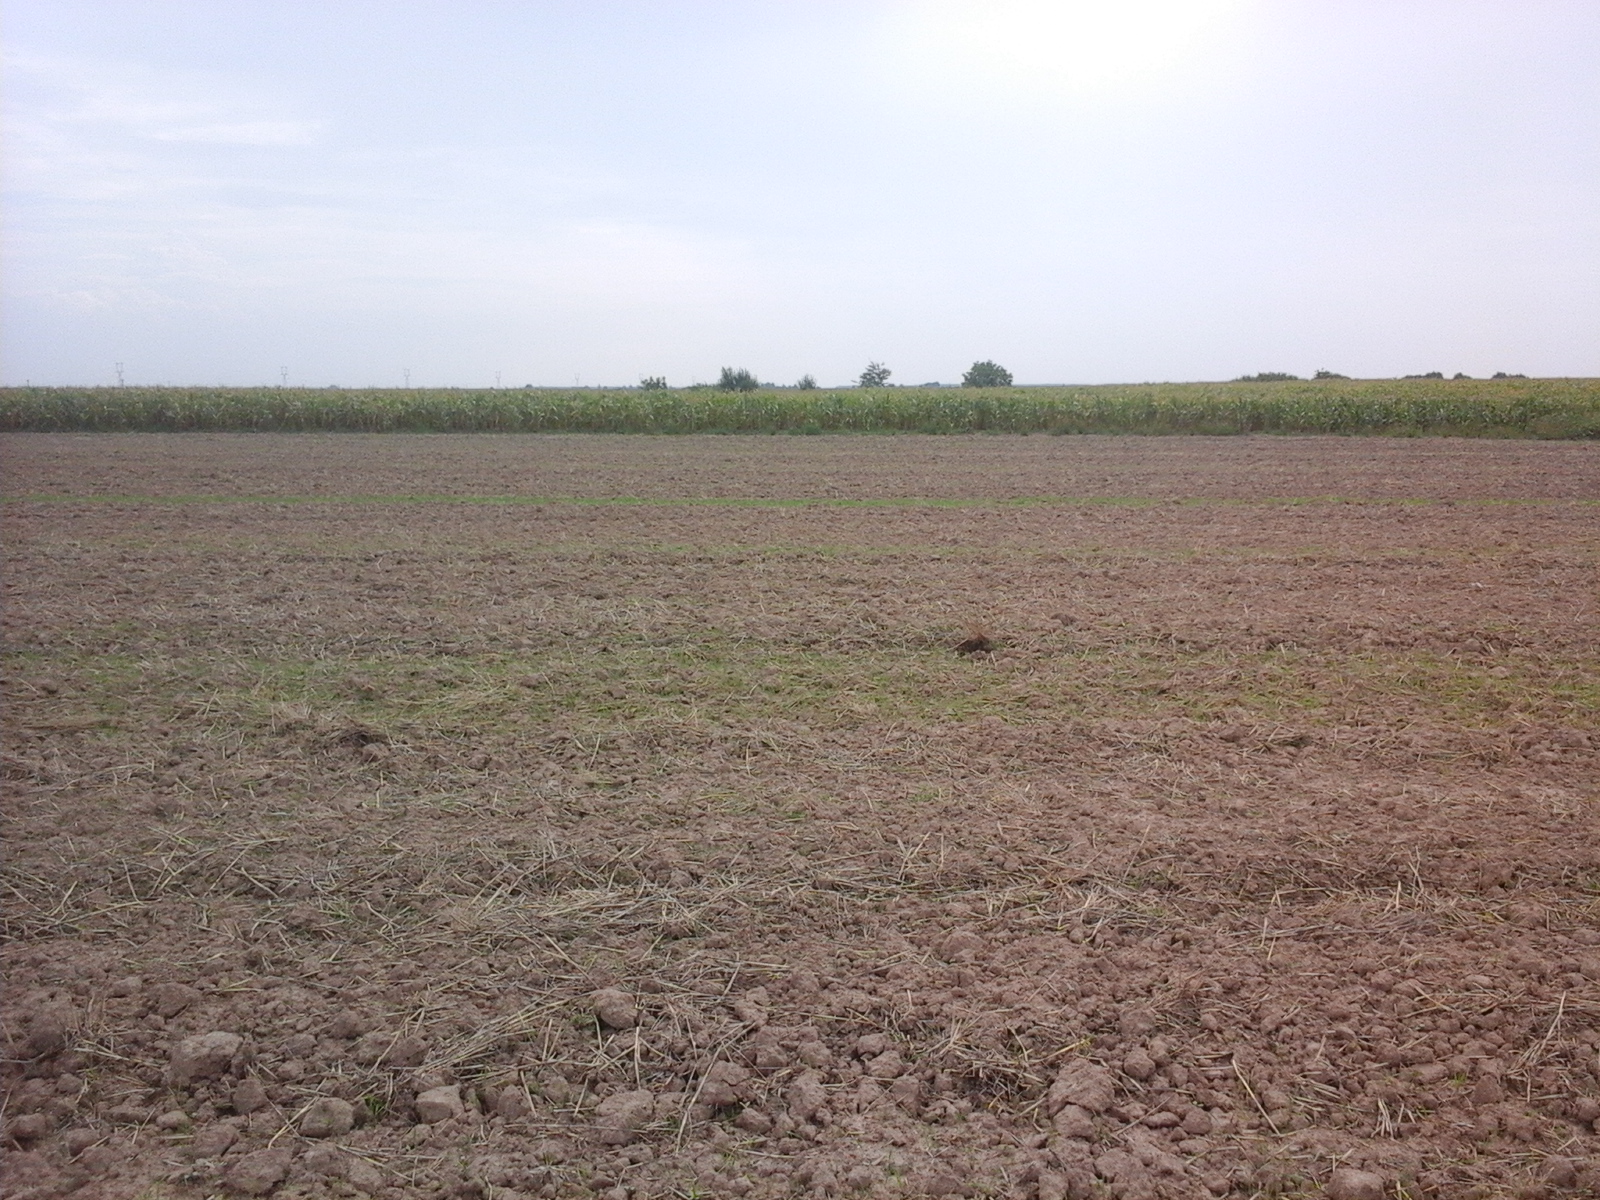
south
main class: Cropland
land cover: Common wheat
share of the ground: < 10 %
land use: Agriculture (excluding fallow land and kitchen gardens)
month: August
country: RO
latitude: 46.7665
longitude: 21.6558
